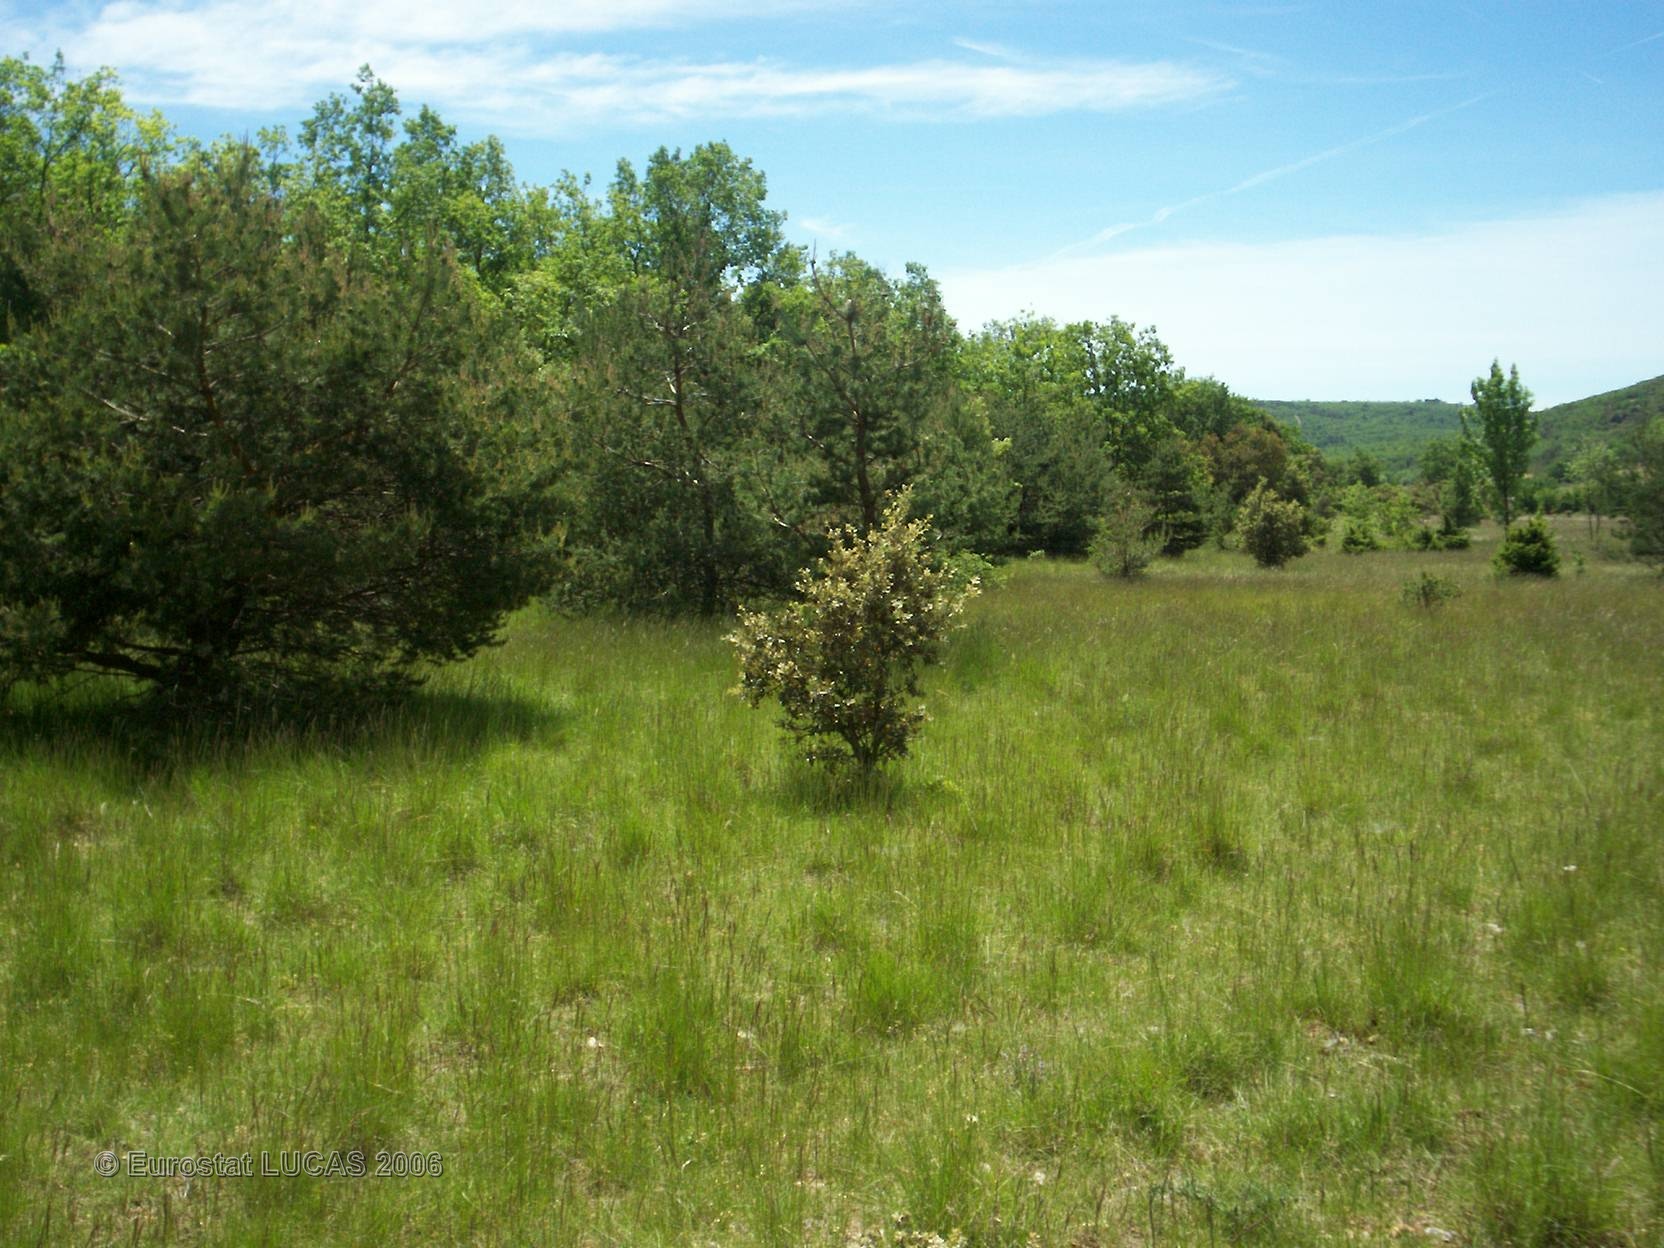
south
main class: Grassland
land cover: Grassland with sparse tree/shrub cover
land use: Agriculture (excluding fallow land and kitchen gardens)
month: May
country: FR
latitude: 44.0095
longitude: 5.3061
